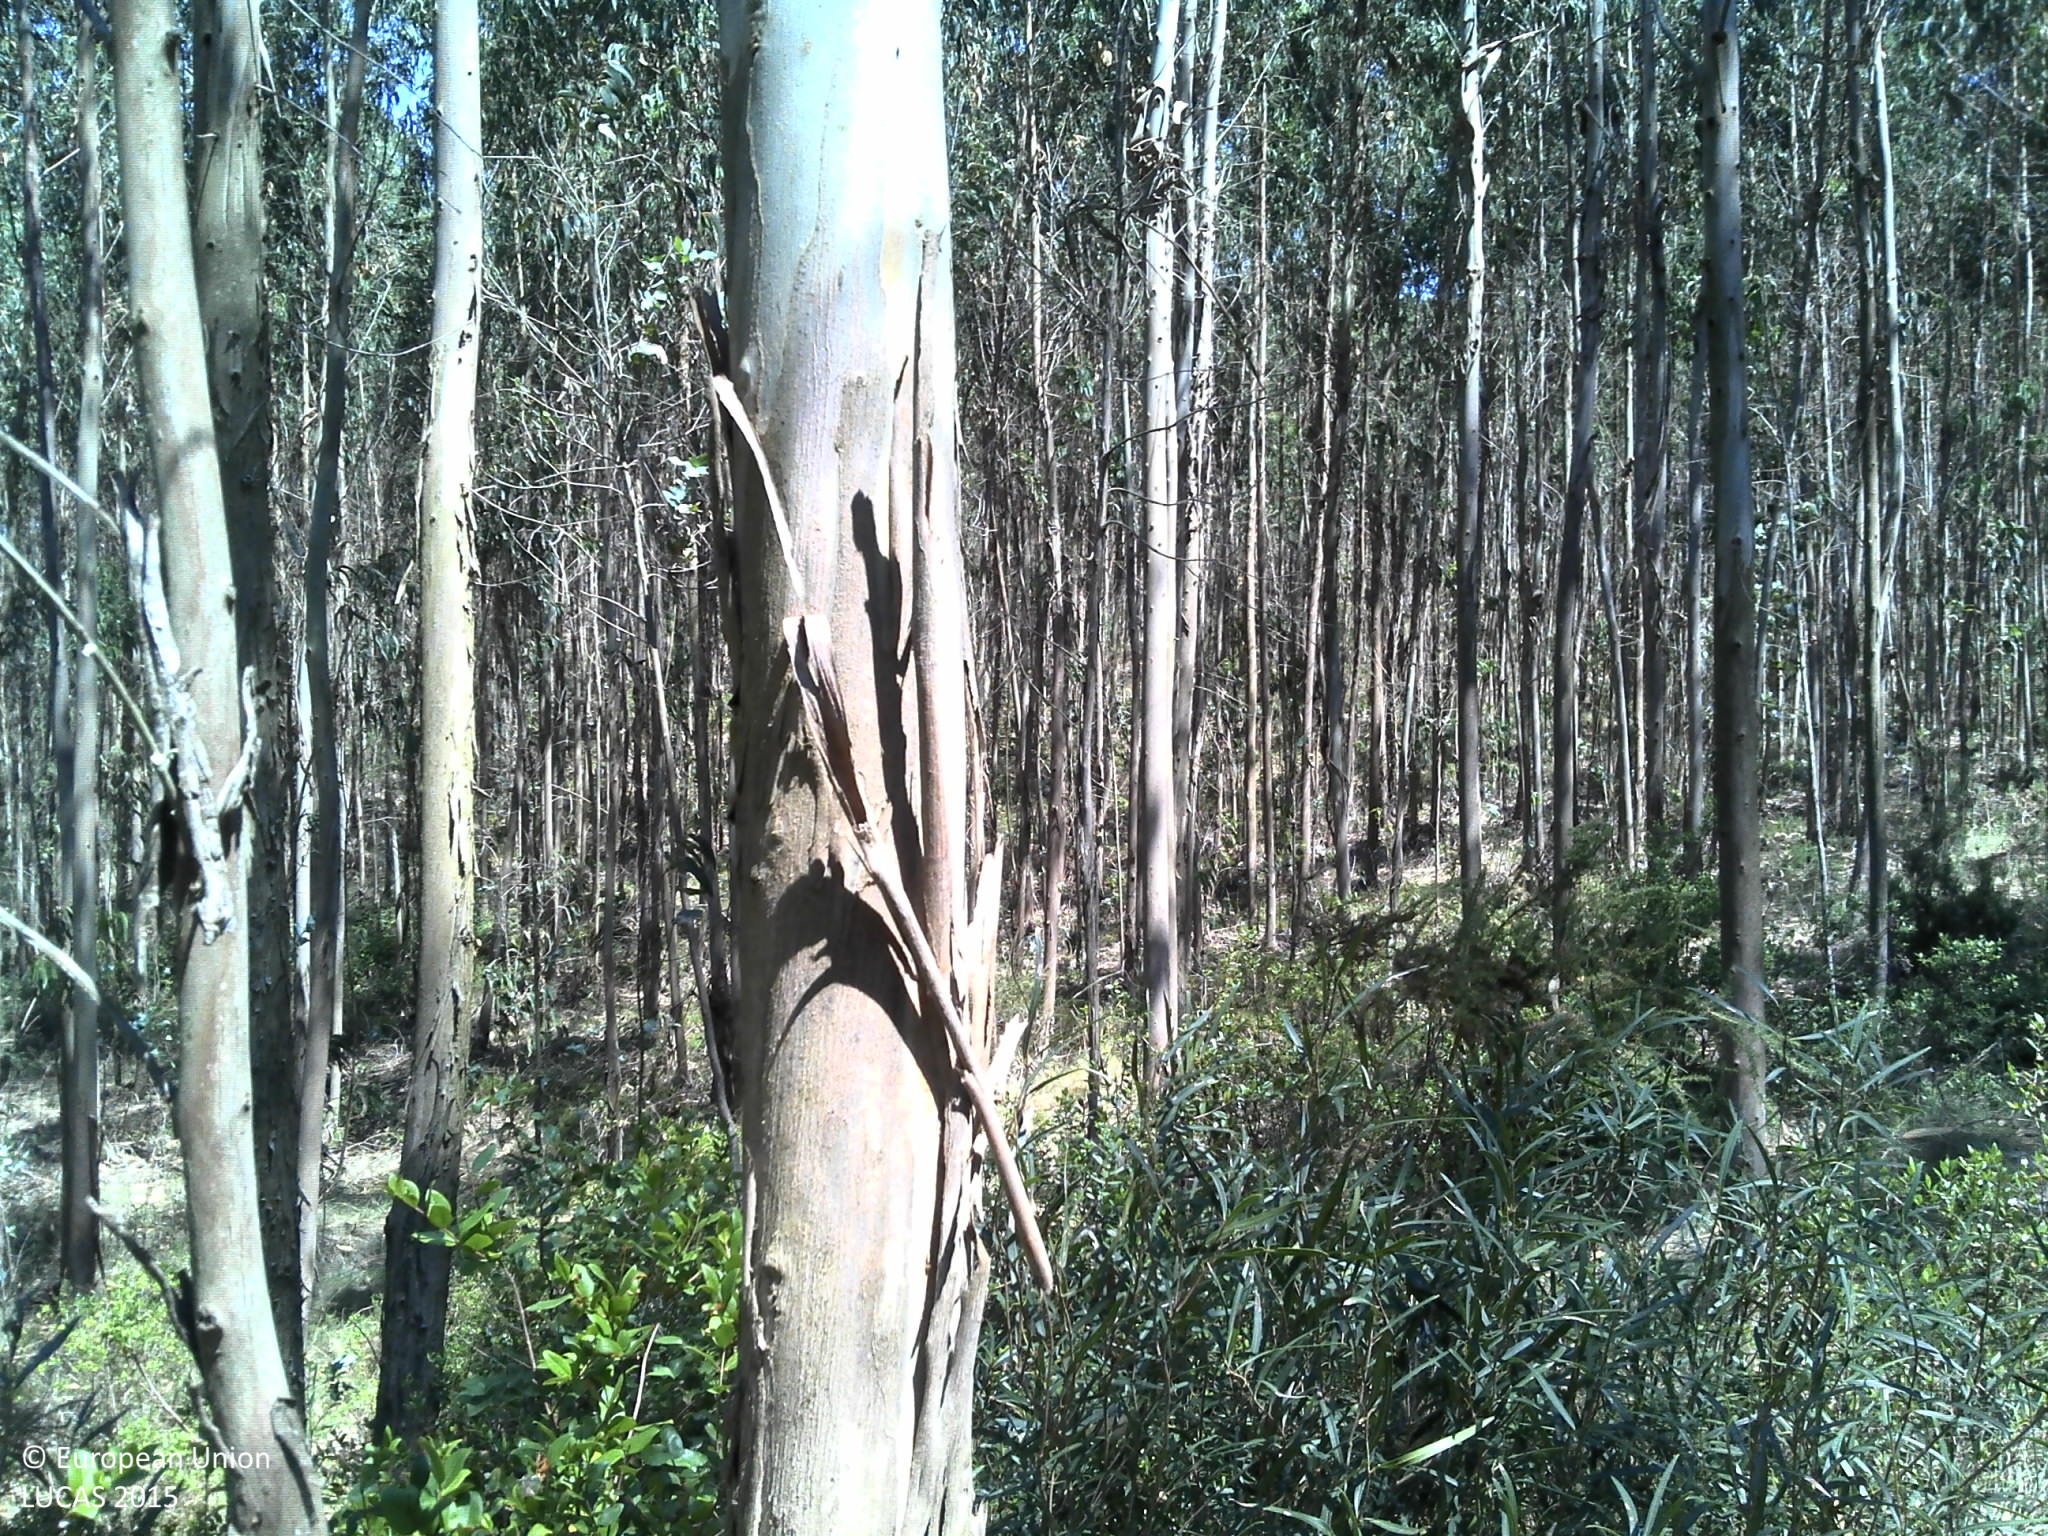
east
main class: Woodland
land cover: Broadleaved woodland
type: exotic forest
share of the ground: 50 - 75 %
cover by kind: broadleaved forest trees 70 %, shrubs 20 %, unconsolidated bare surface 10 %
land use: Forestry
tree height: > 5 m
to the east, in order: Broadleaved woodland; Tracks; Broadleaved woodland
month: June
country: PT
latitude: 39.1841
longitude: -9.2951
